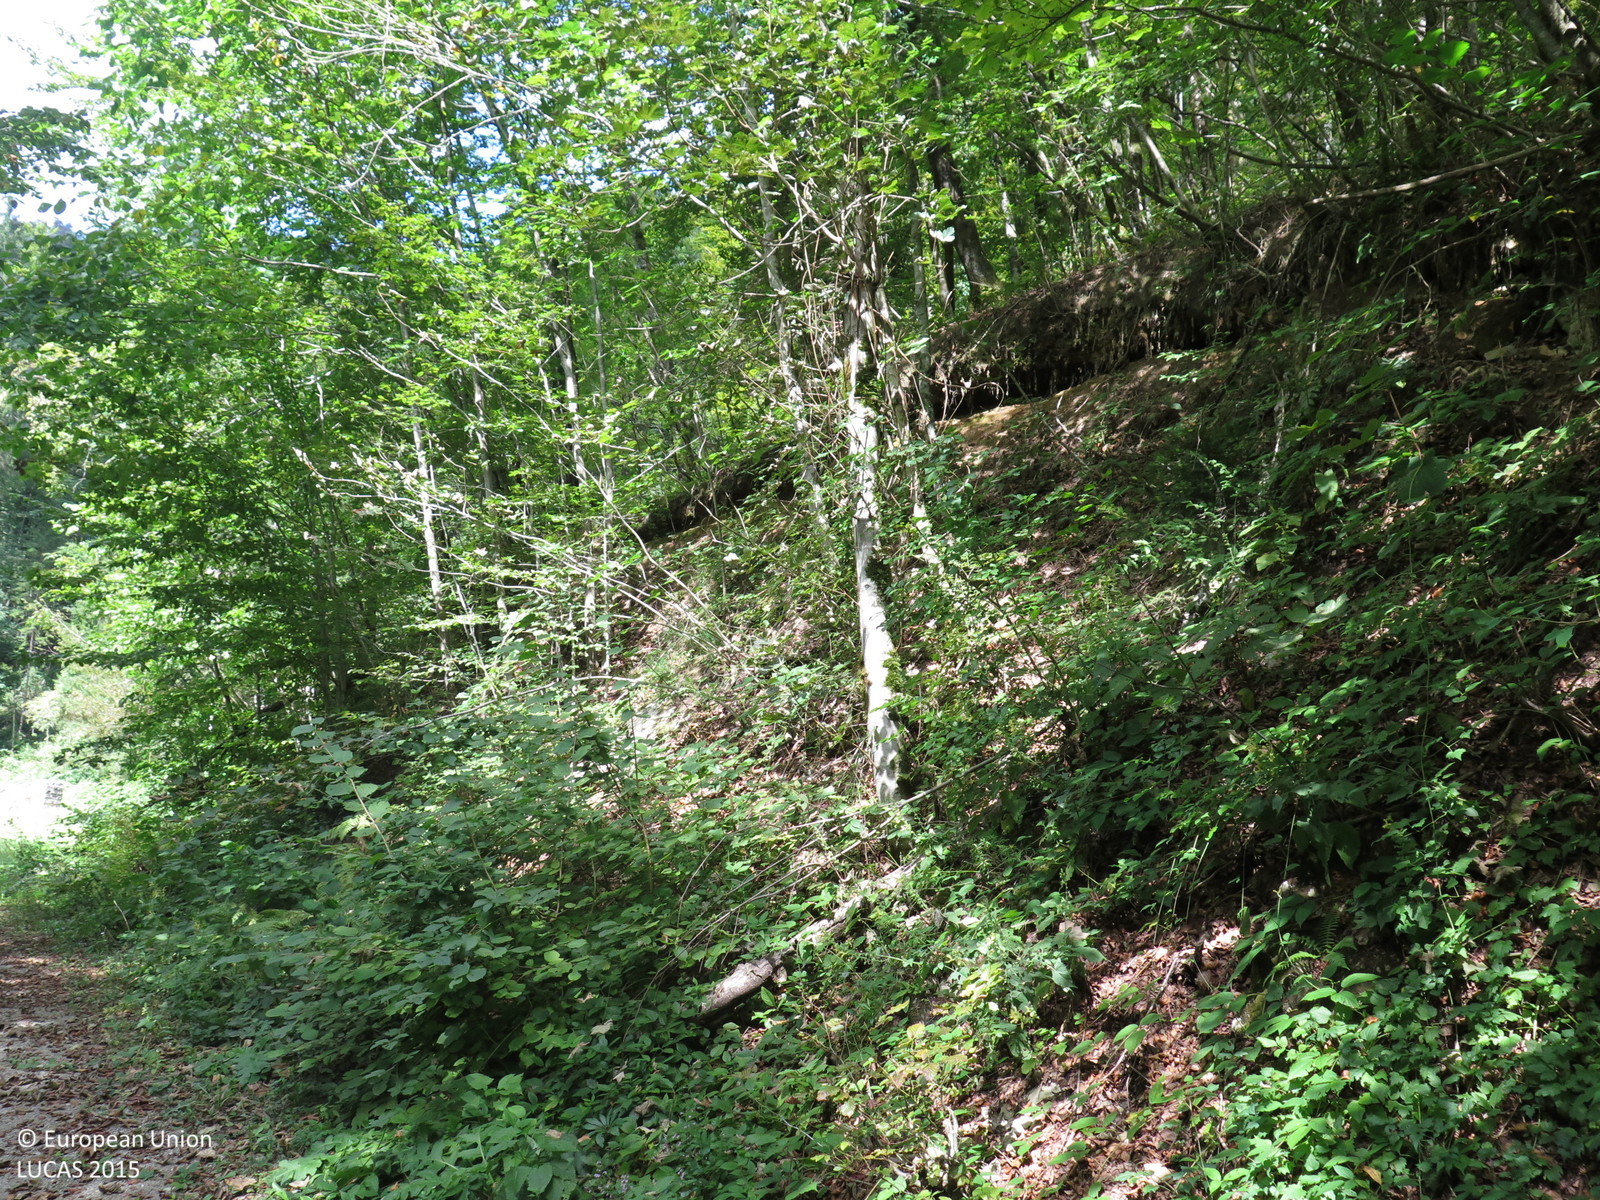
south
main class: Woodland
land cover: Broadleaved woodland
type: beech forest
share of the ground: > 75 %
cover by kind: broadleaved forest trees 90 %, shrubs 5 %, herbaceous plants 5 %
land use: Forestry
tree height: > 5 m
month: September
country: HR
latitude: 45.4870
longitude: 14.7679
